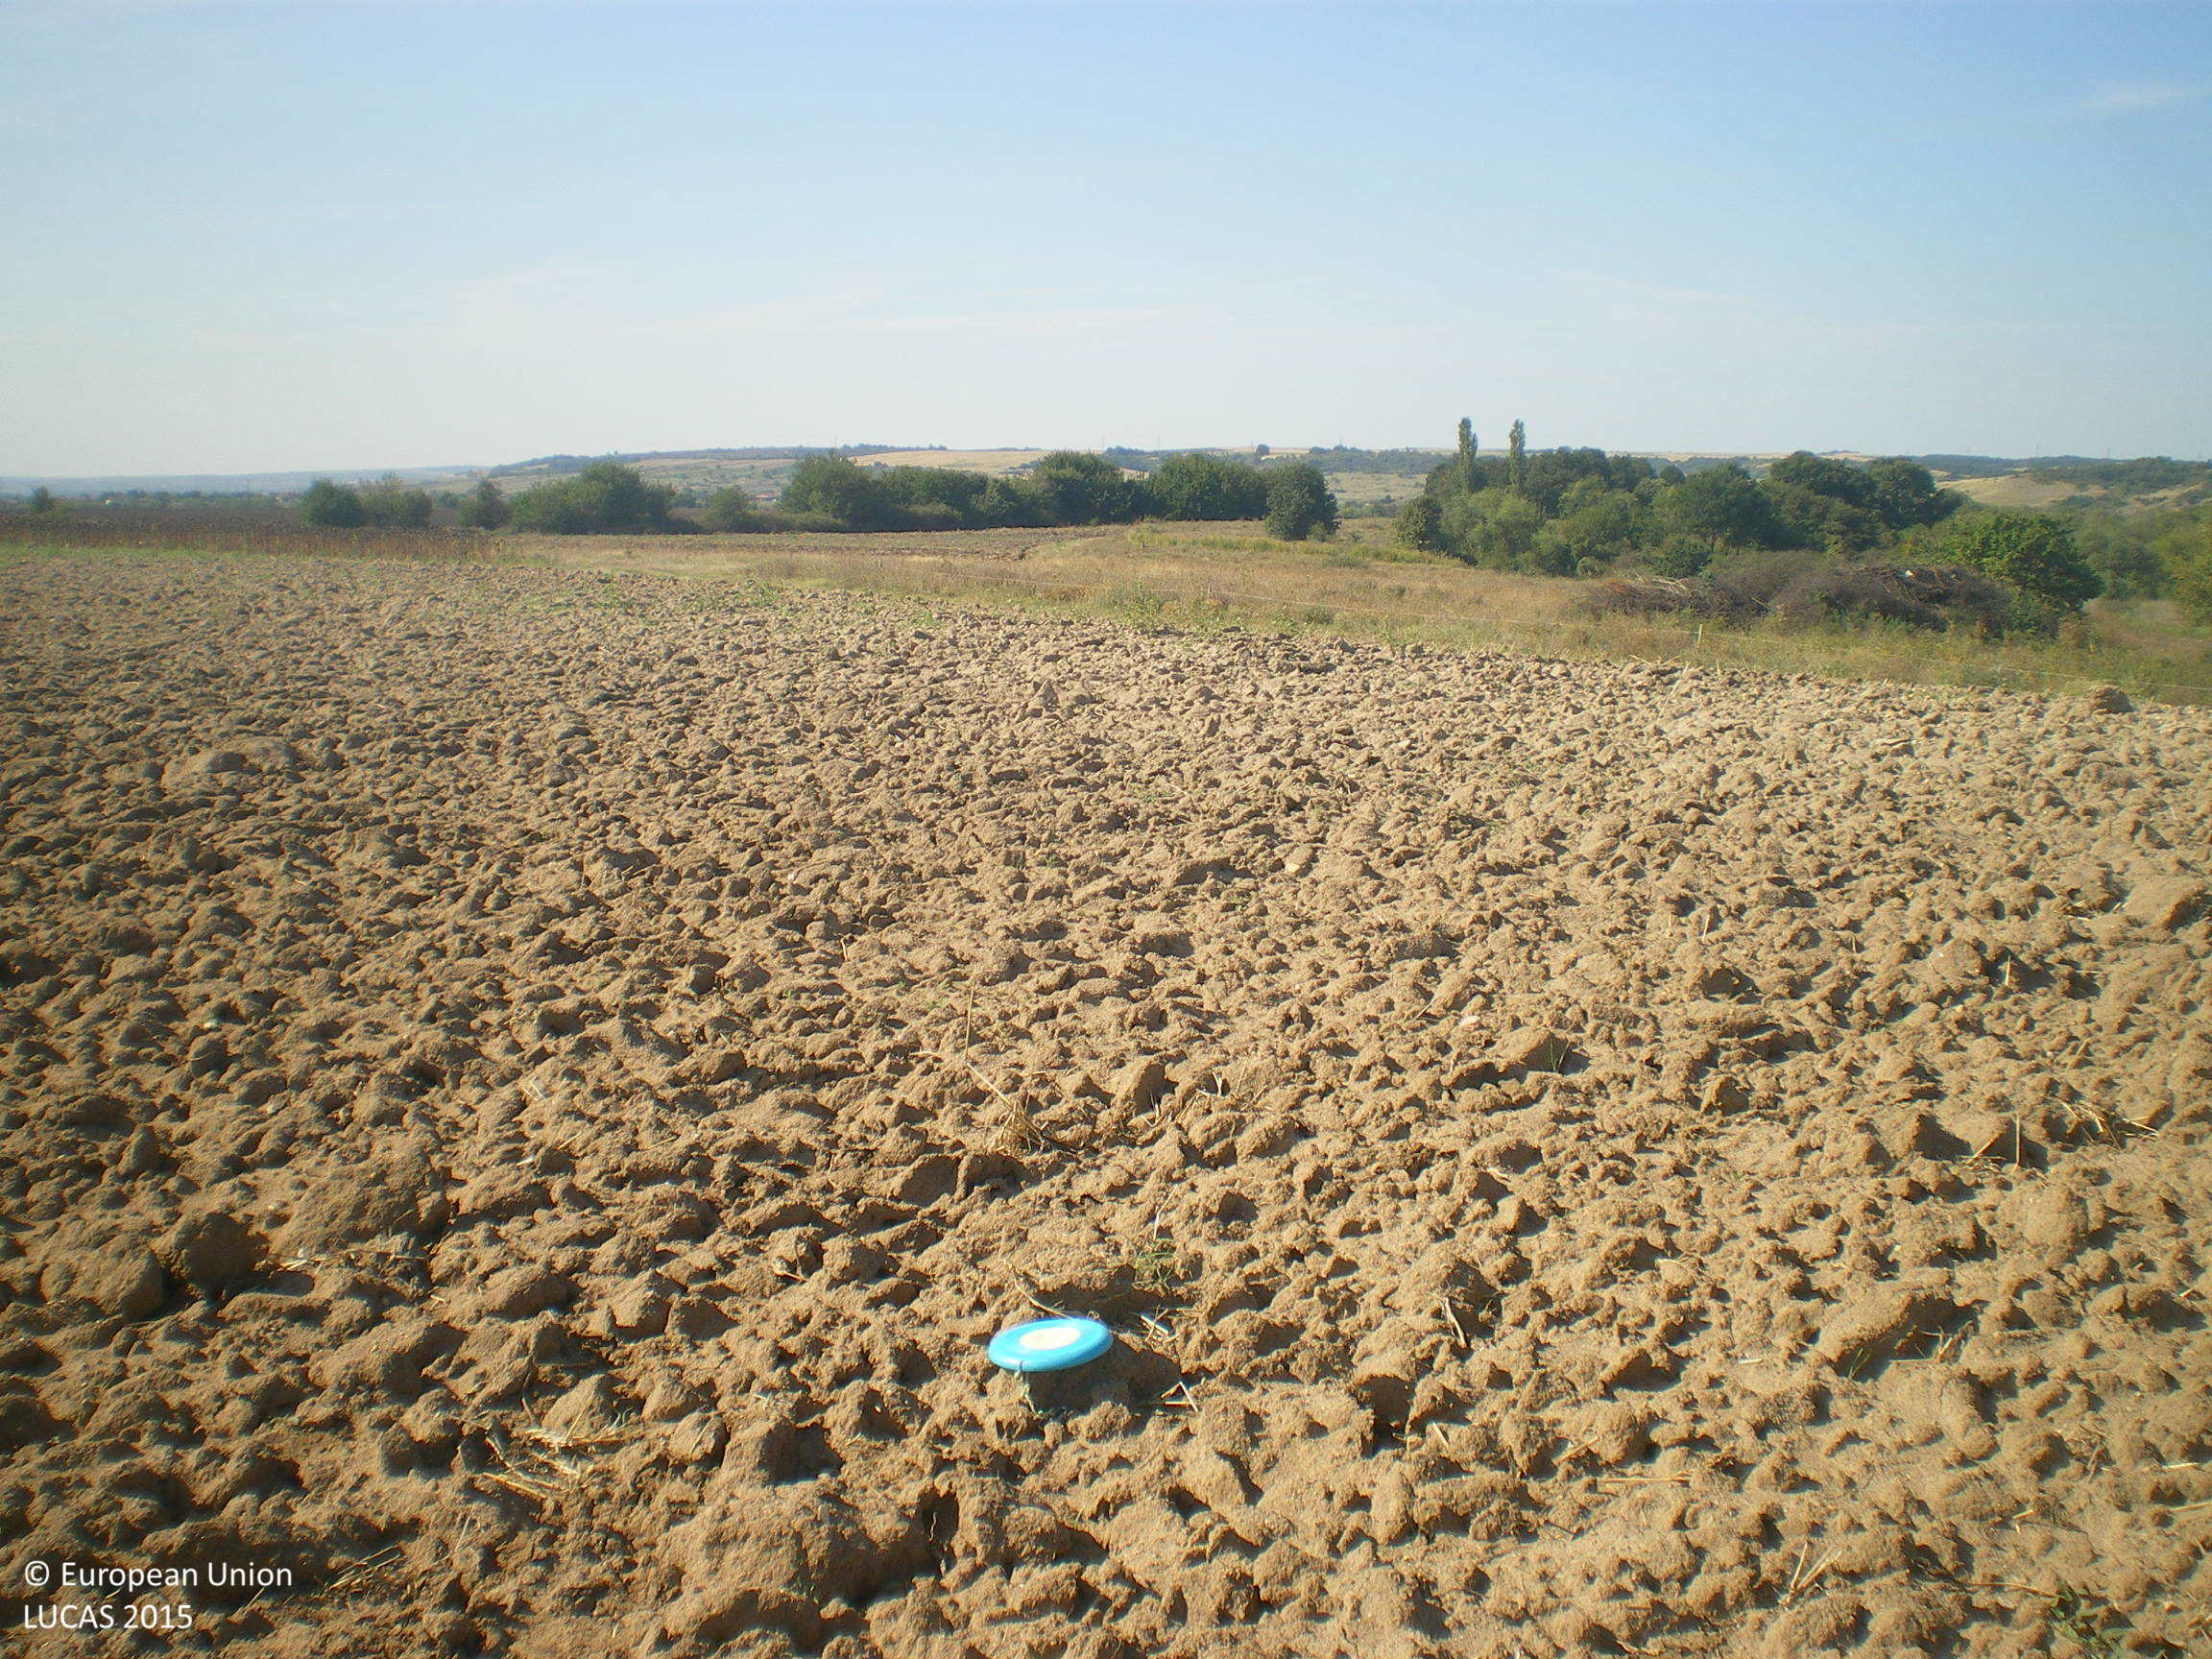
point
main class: Cropland
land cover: Common wheat
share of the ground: < 10 %
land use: Agriculture (excluding fallow land and kitchen gardens)
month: September
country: BG
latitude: 42.1085
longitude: 25.8792
